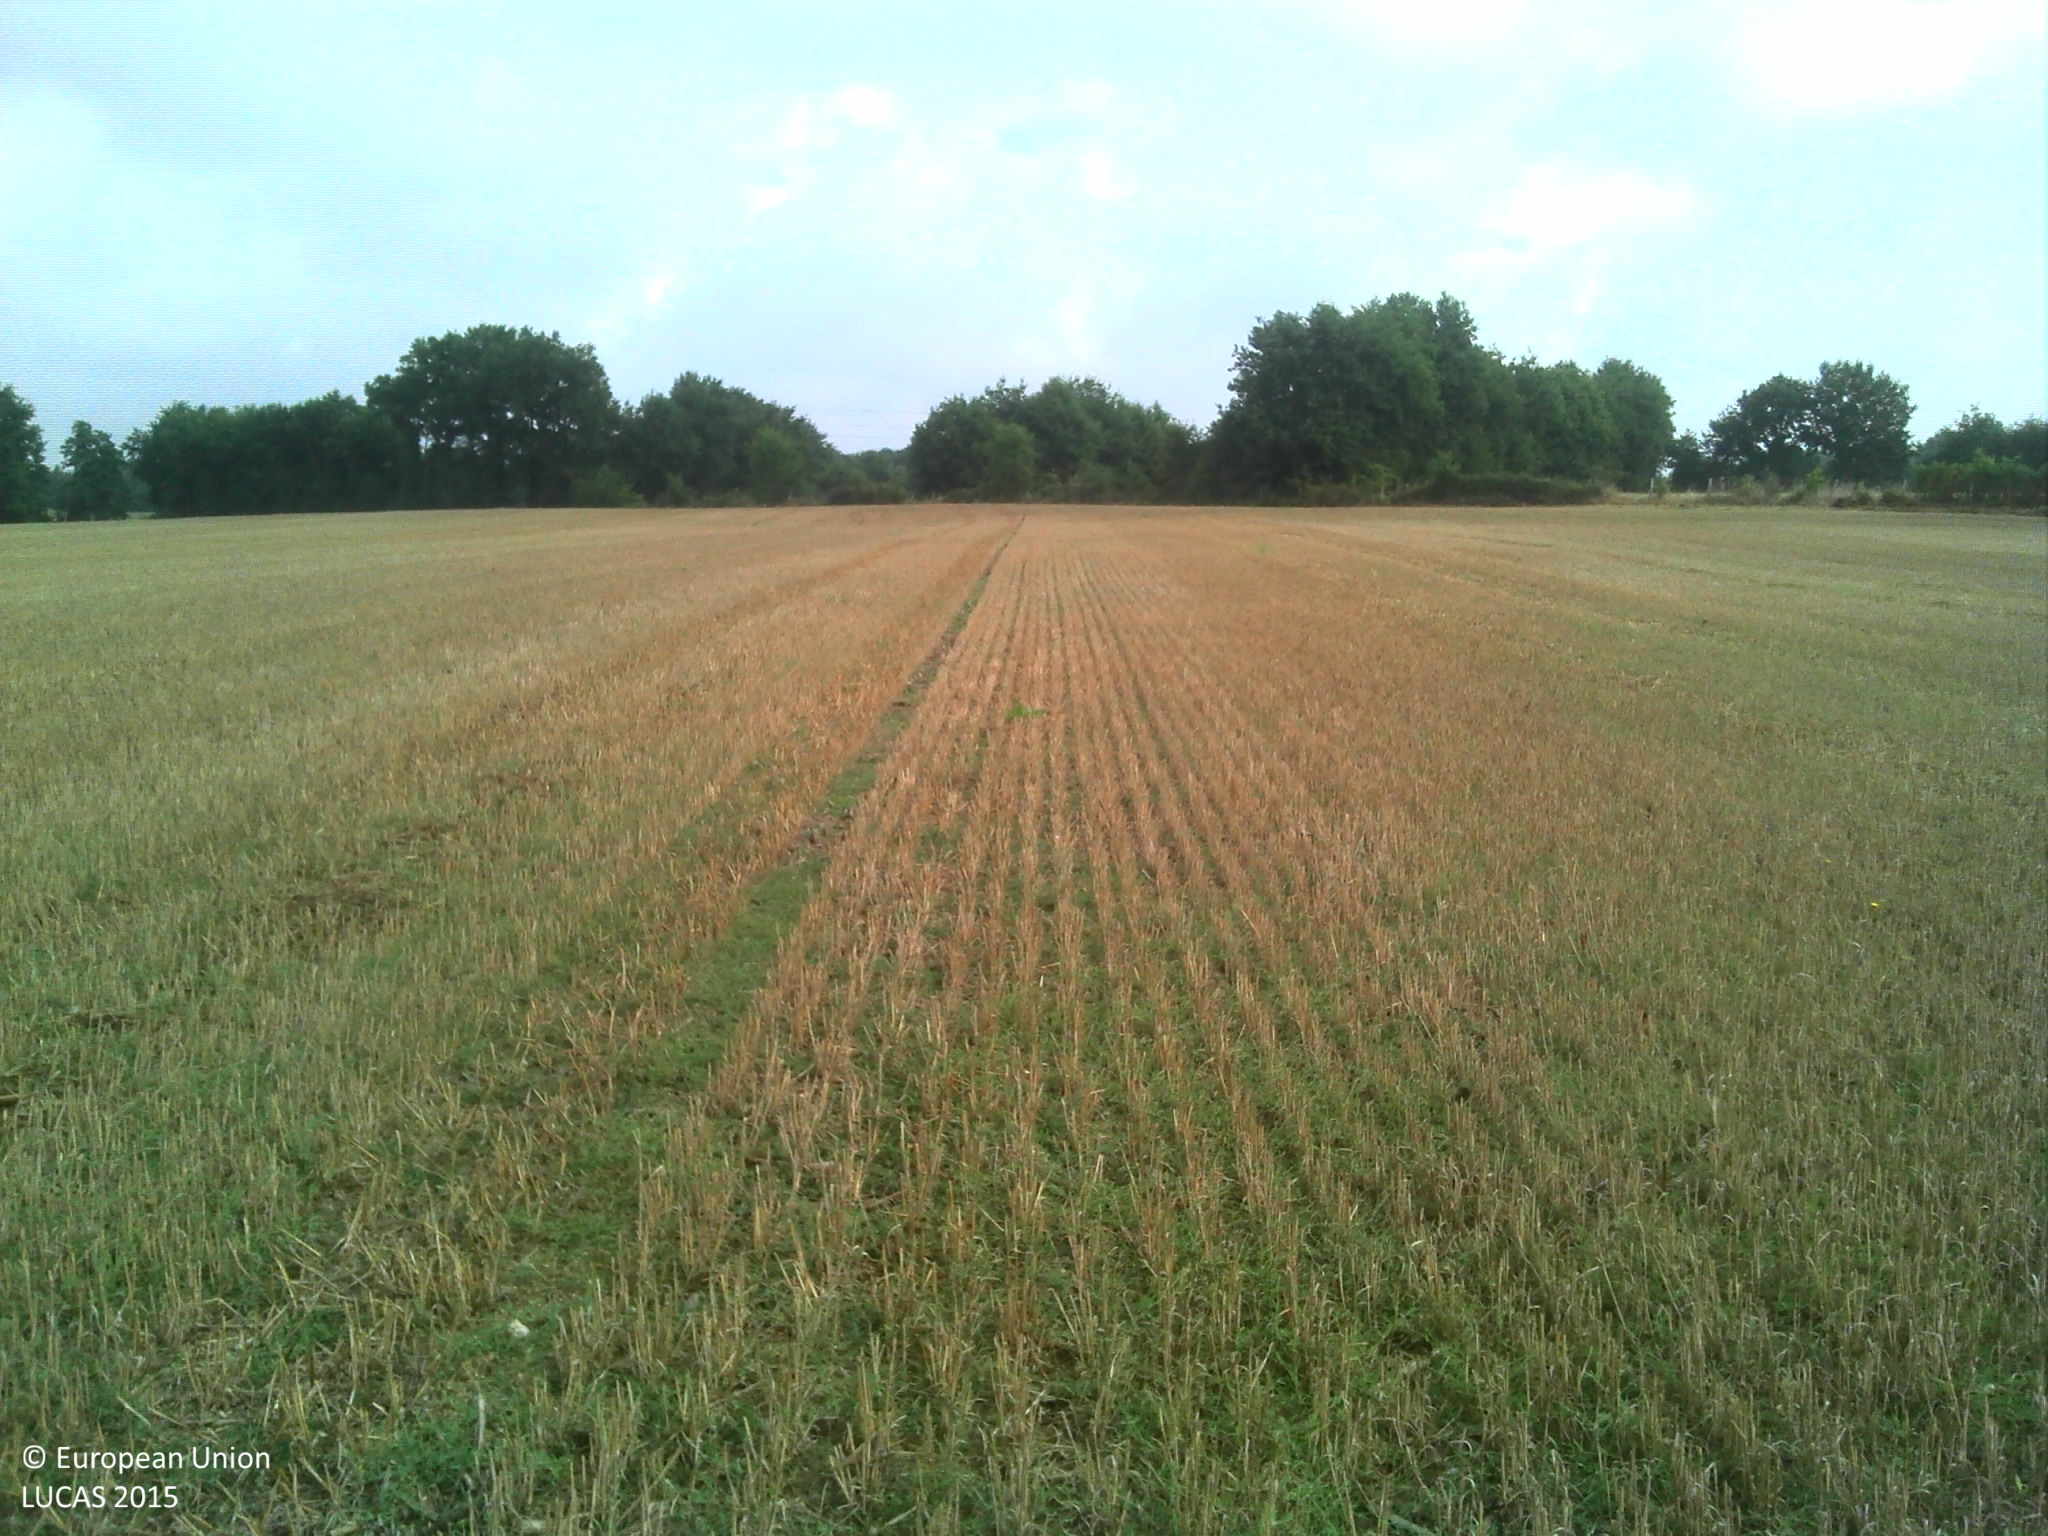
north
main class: Cropland
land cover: Barley
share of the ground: > 75 %
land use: Agriculture (excluding fallow land and kitchen gardens)
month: August
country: FR
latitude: 46.6656
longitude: -1.5804
